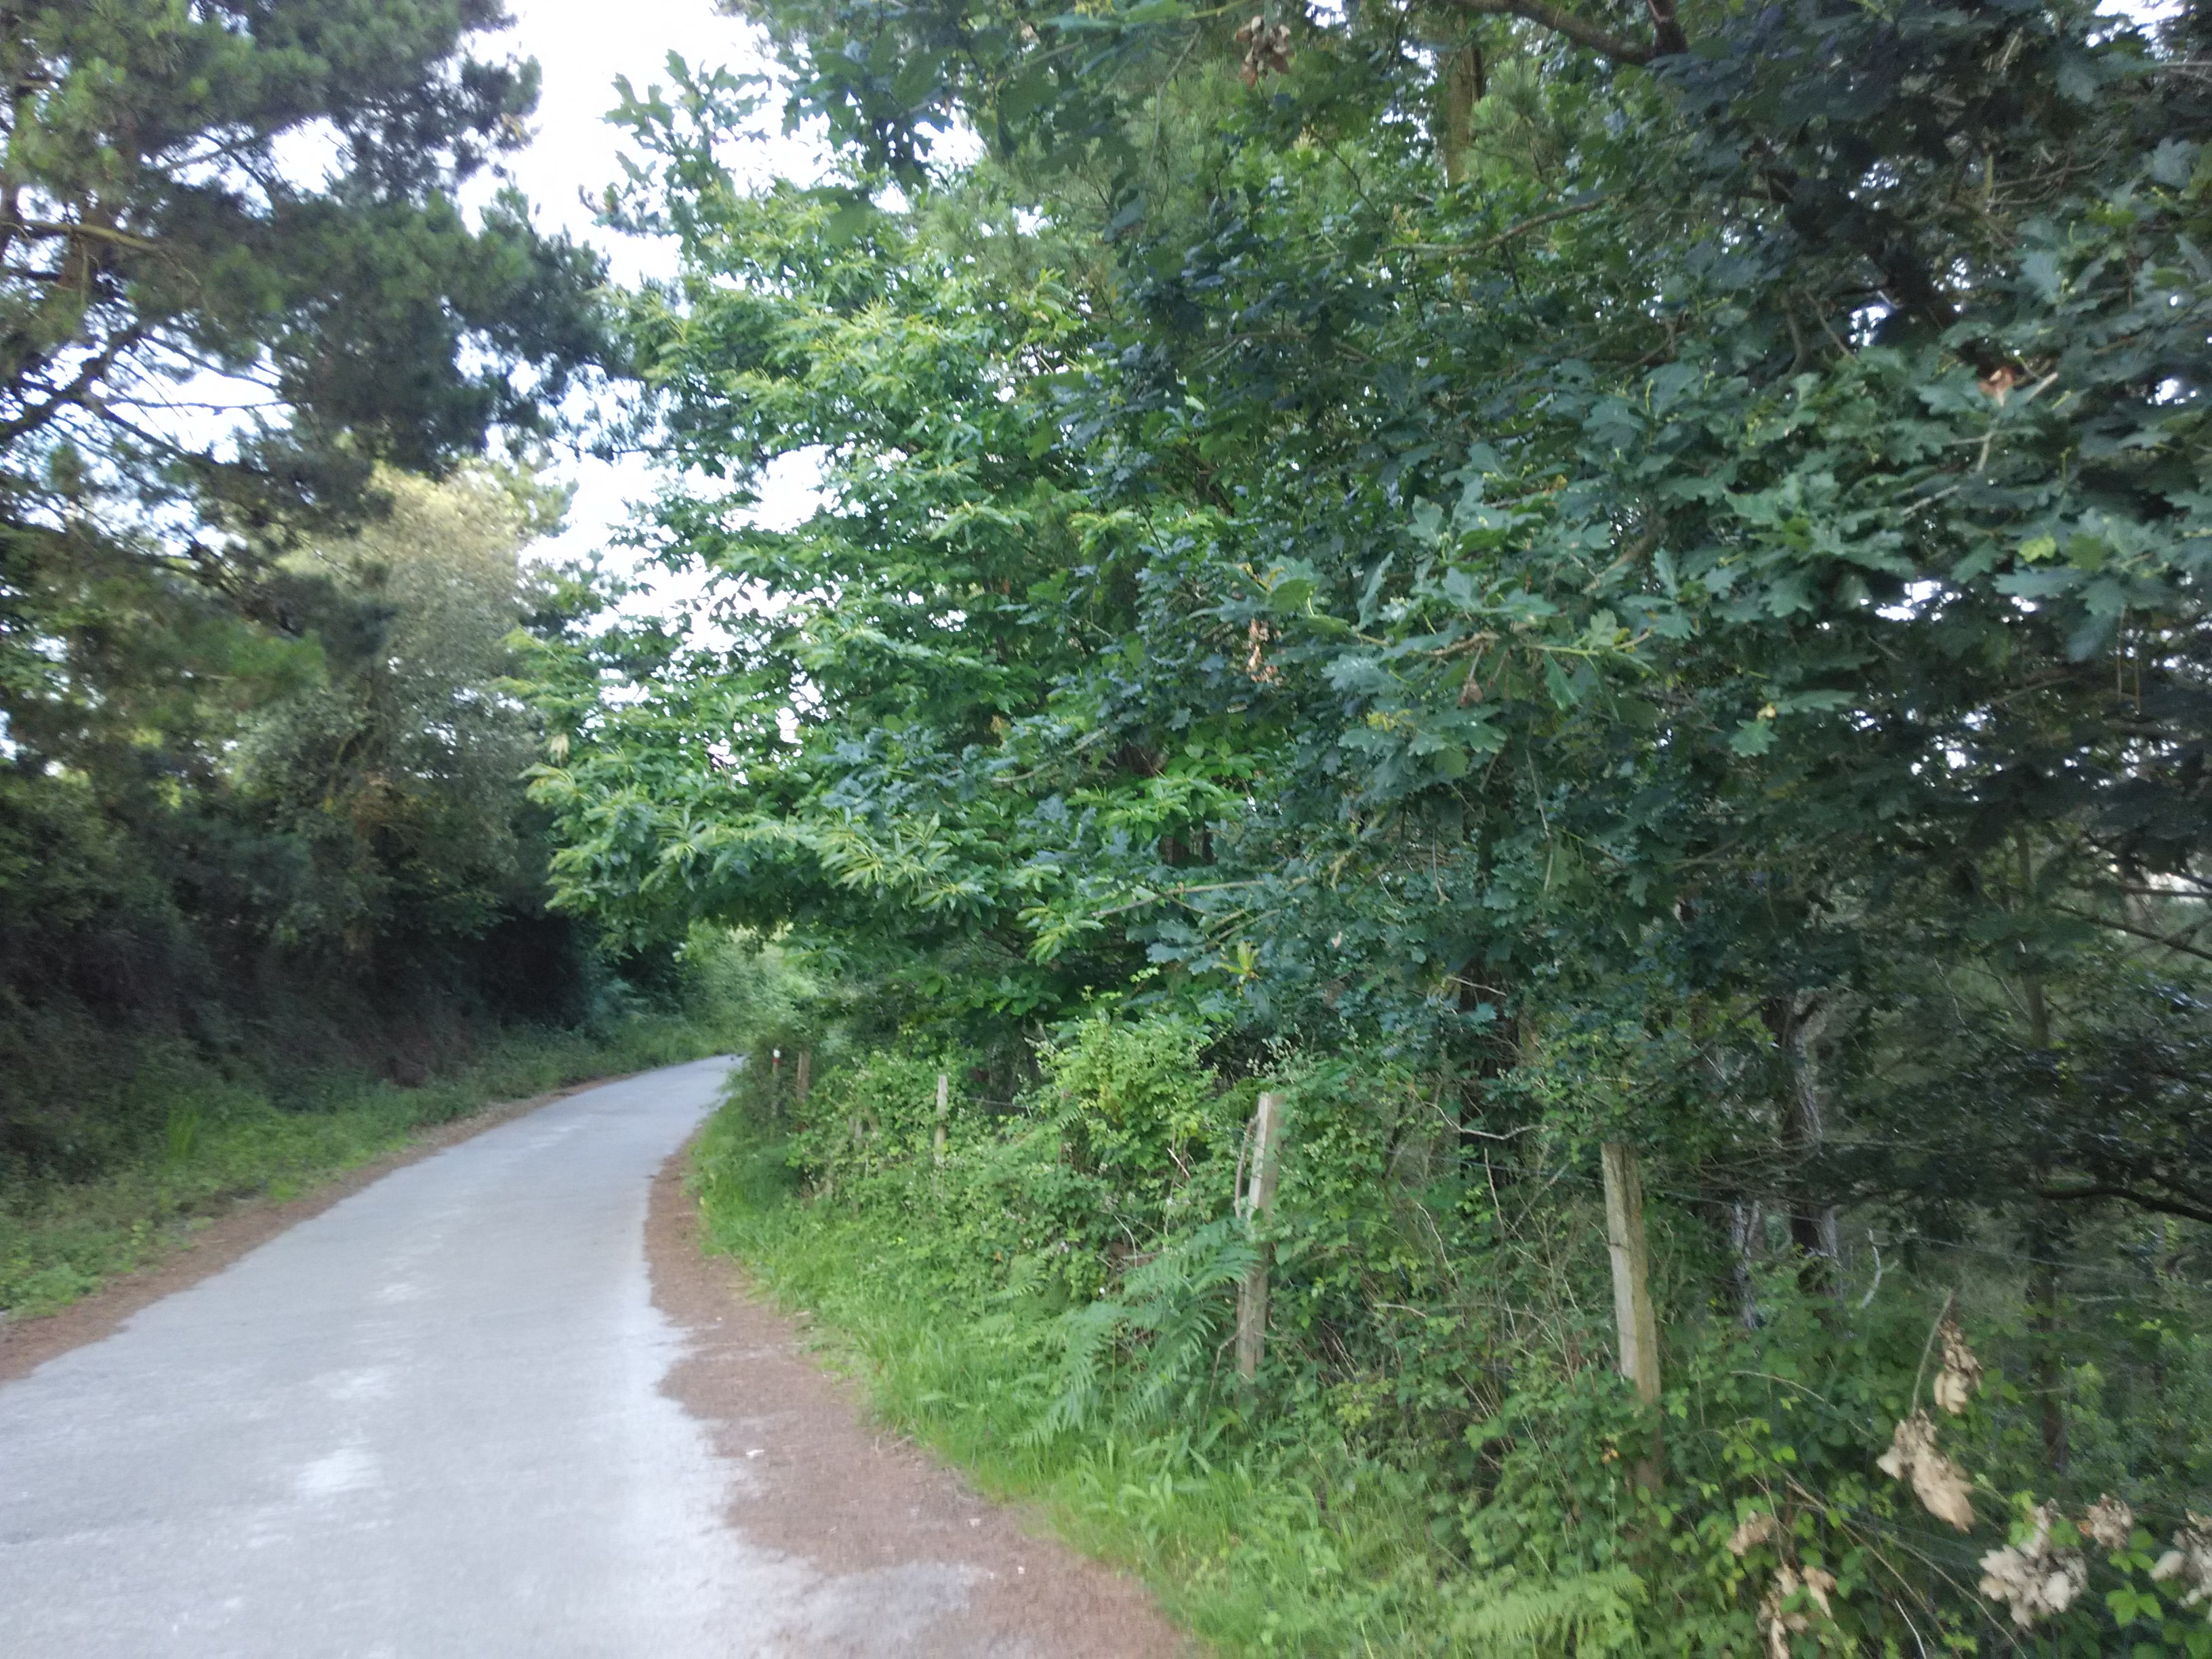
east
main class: Woodland
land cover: Pine dominated coniferous woodland
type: exotic forest
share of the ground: > 75 %
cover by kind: coniferous forest trees 80 %, shrubs 20 %
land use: Forestry
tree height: > 5 m
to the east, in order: Pine dominated coniferous woodland; Broadleaved woodland; Other bare soil
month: June
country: ES
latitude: 43.3245
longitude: -2.4463
